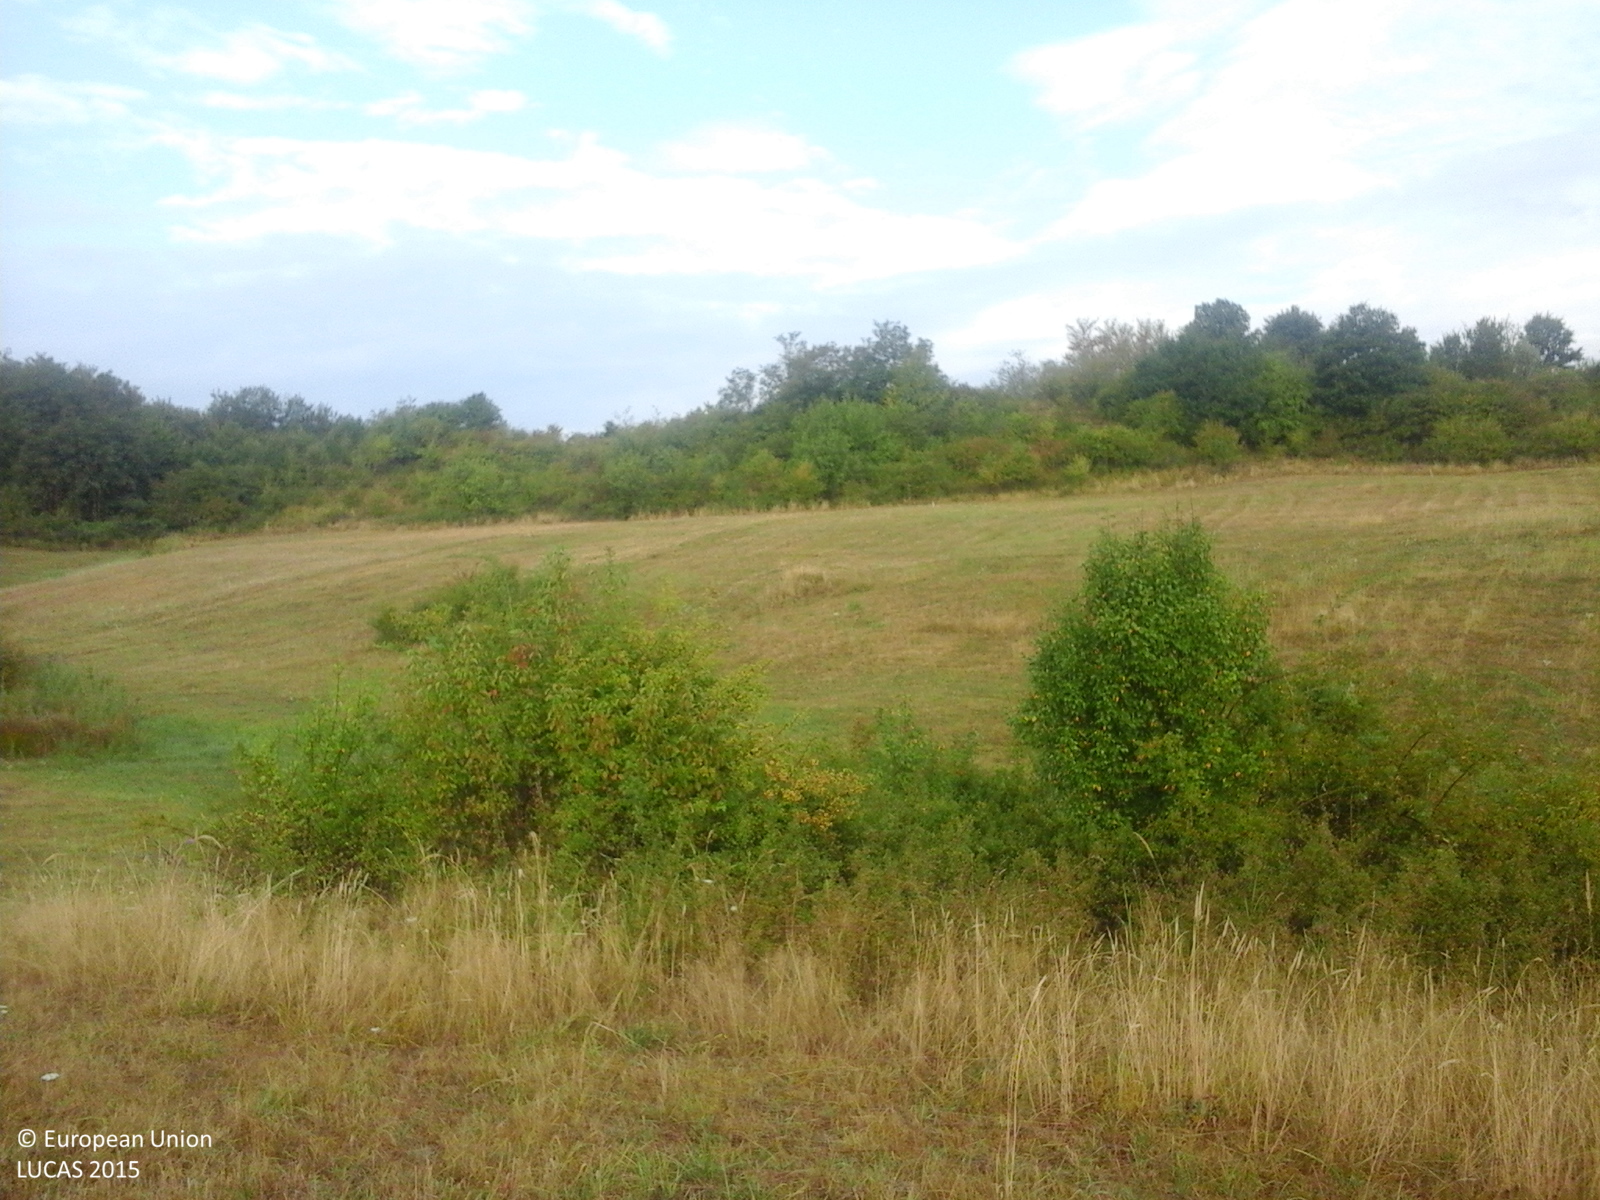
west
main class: Grassland
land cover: Grassland without tree/shrub cover
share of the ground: > 75 %
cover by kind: herbaceous plants 100 %
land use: Agriculture (excluding fallow land and kitchen gardens)
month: August
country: RO
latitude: 44.7738
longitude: 22.8202
